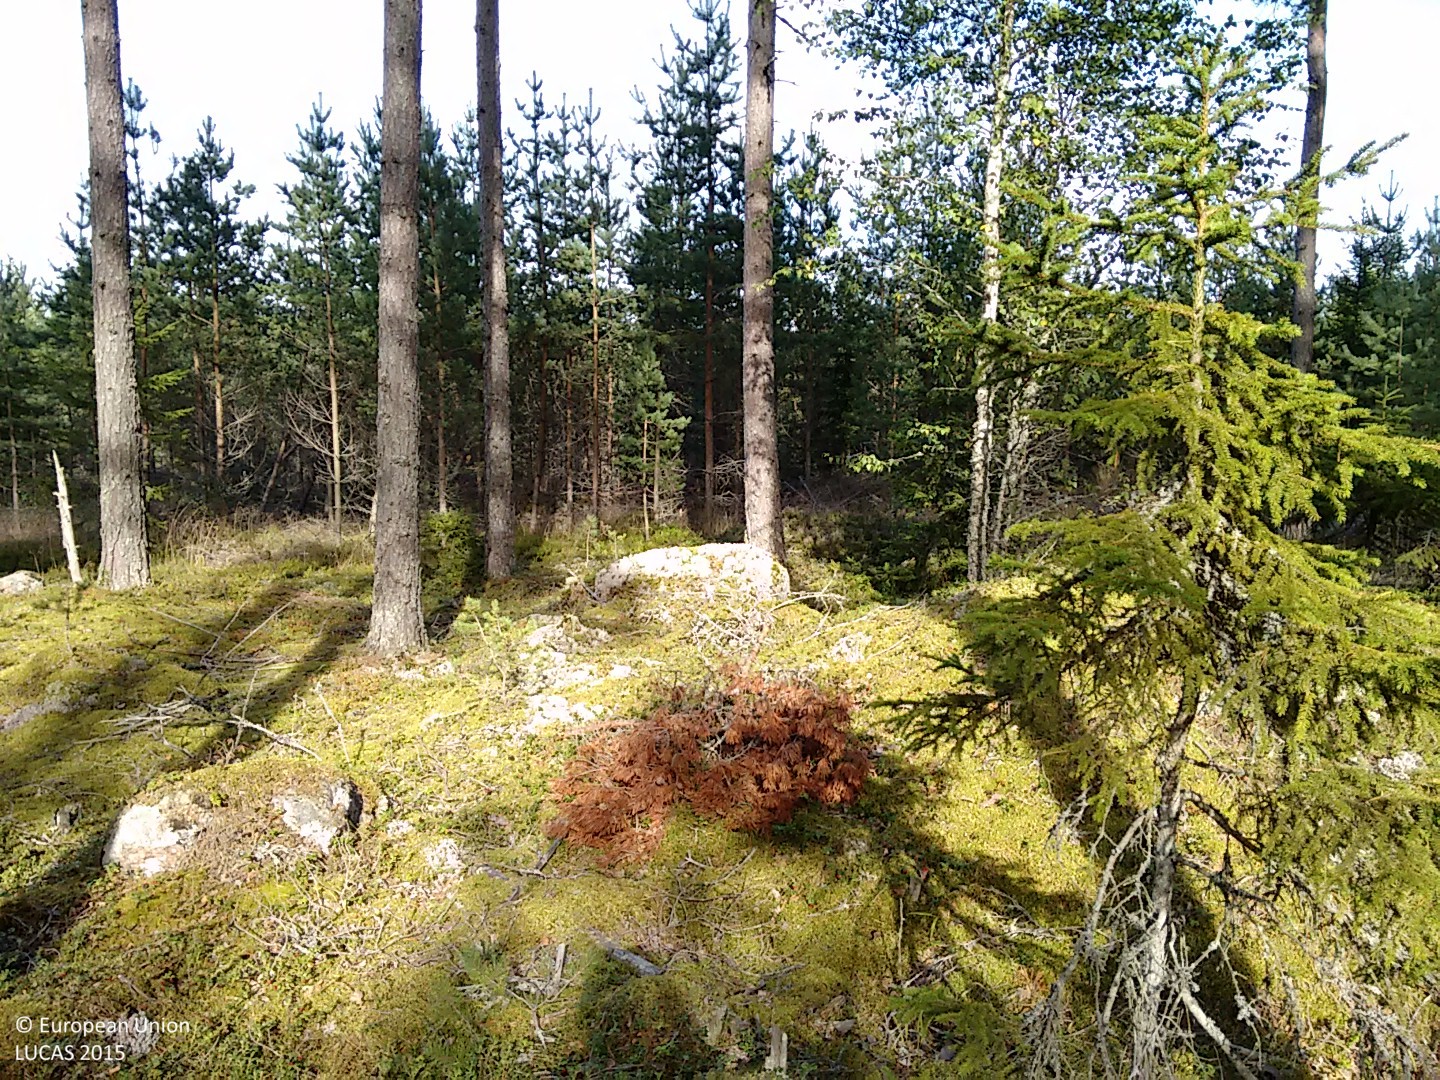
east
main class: Woodland
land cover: Pine dominated coniferous woodland
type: hemiboreal forest and nemoral coniferous forest and mixed broadleaved-coniferous forest
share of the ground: 50 - 75 %
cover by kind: coniferous forest trees 70 %, shrubs 30 %
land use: Forestry
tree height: > 5 m
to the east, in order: Pine dominated coniferous woodland; Tracks; Pine dominated coniferous woodland; Pine dominated mixed woodland; Pine dominated coniferous woodland
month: September
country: FI
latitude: 60.8166
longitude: 21.7694
